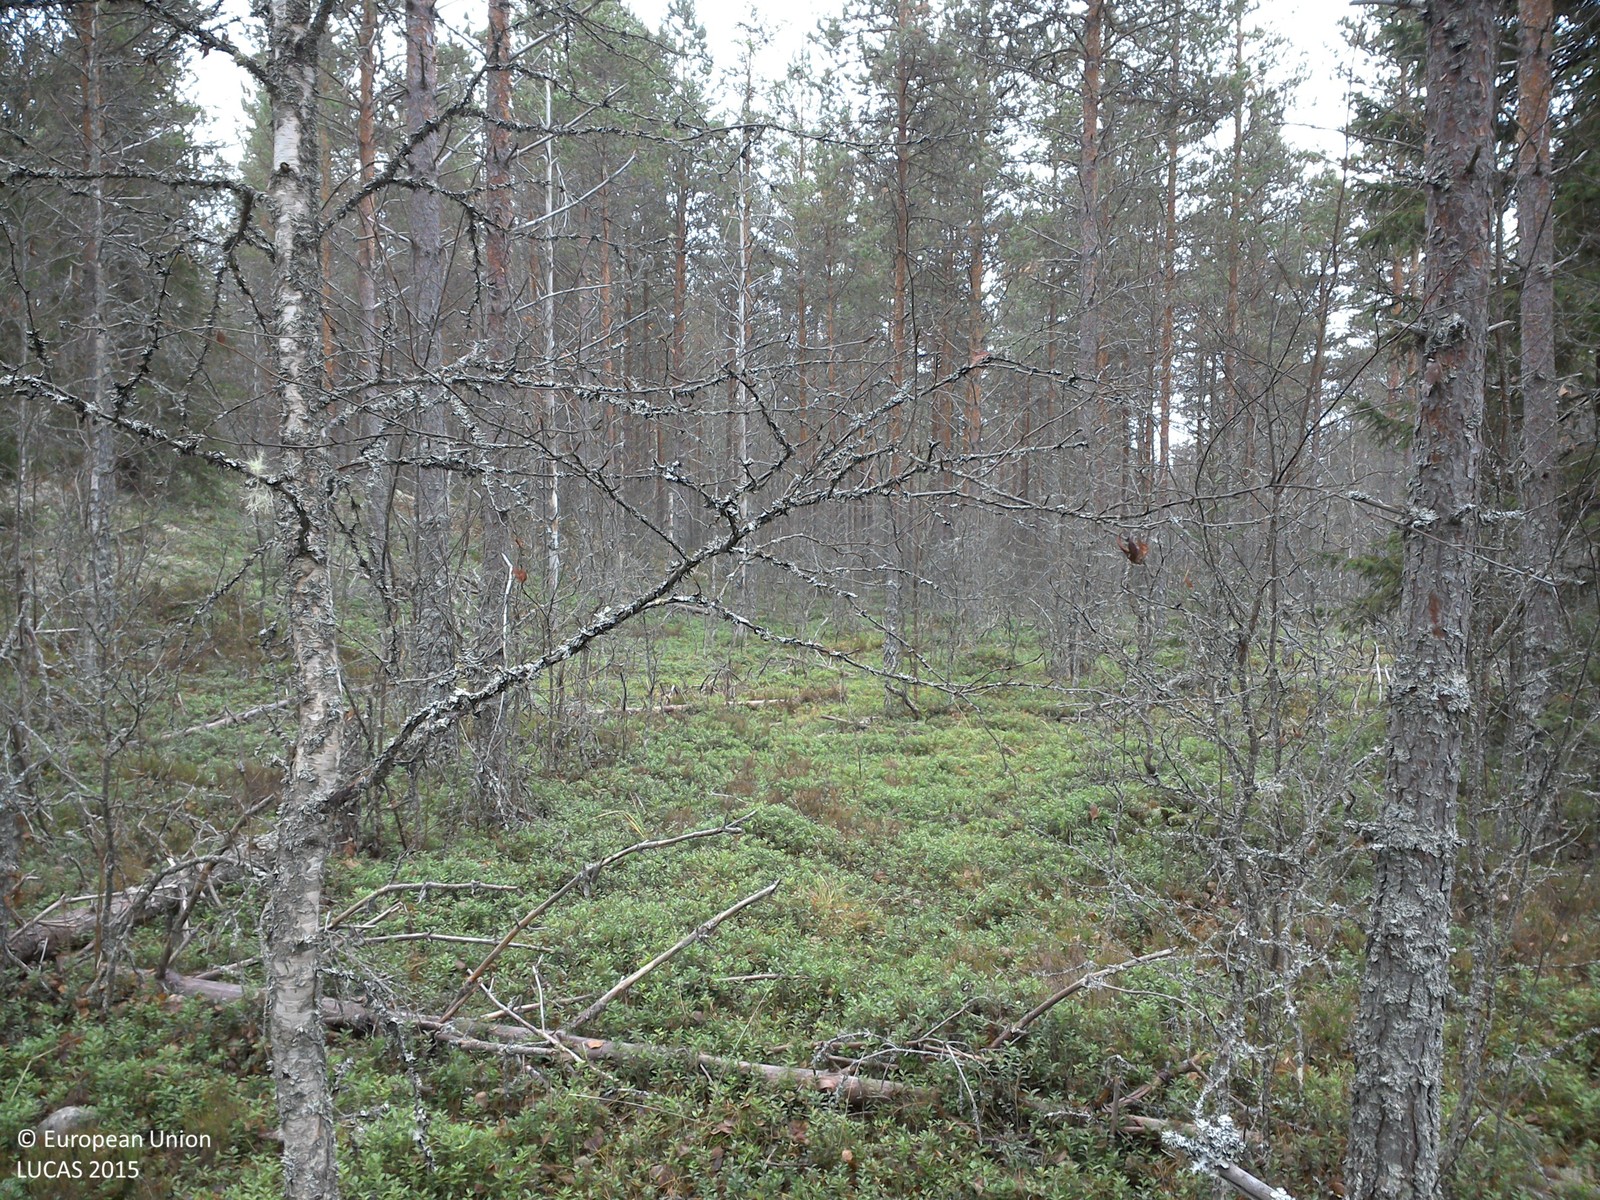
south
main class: Woodland
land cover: Pine dominated coniferous woodland
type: boreal forest
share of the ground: > 75 %
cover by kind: coniferous forest trees 65 %, shrubs 20 %, broadleaved forest trees 15 %
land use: Forestry
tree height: > 5 m
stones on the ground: < 10 %
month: November
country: SE
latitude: 60.1726
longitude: 14.1890
